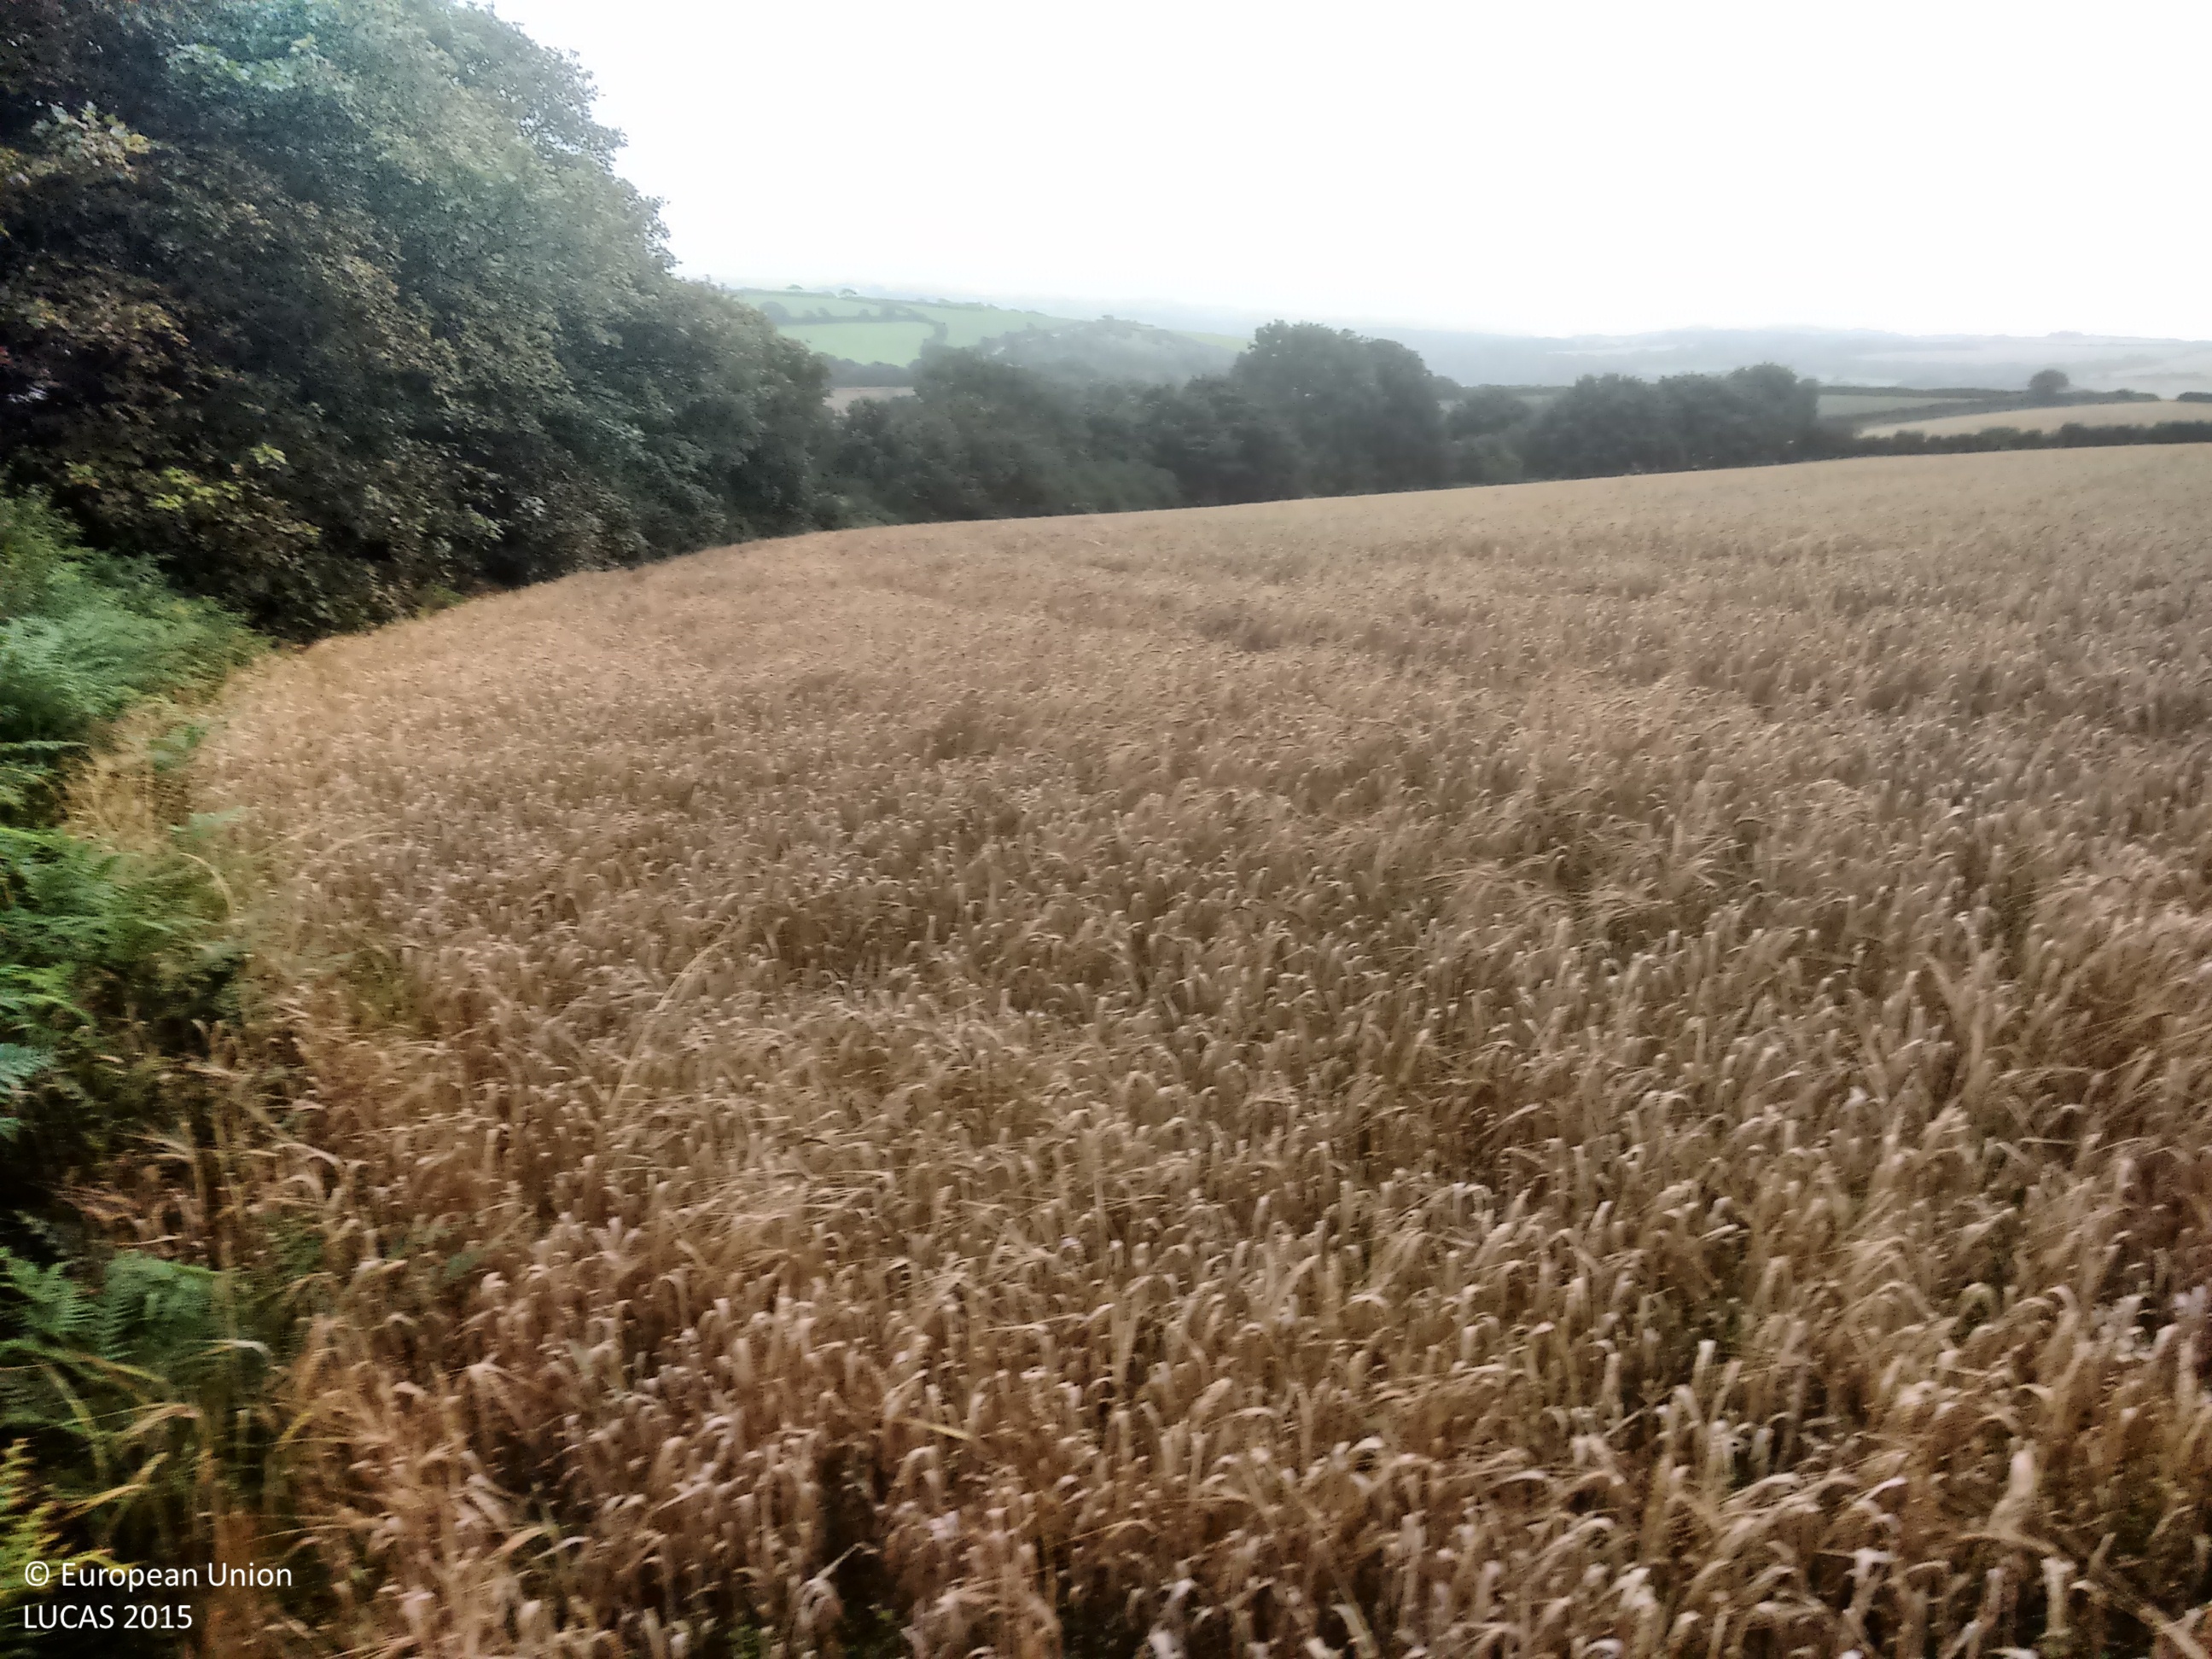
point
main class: Cropland
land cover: Barley
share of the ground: > 75 %
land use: Agriculture (excluding fallow land and kitchen gardens)
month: August
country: GB
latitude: 50.1154
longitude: -5.1525
